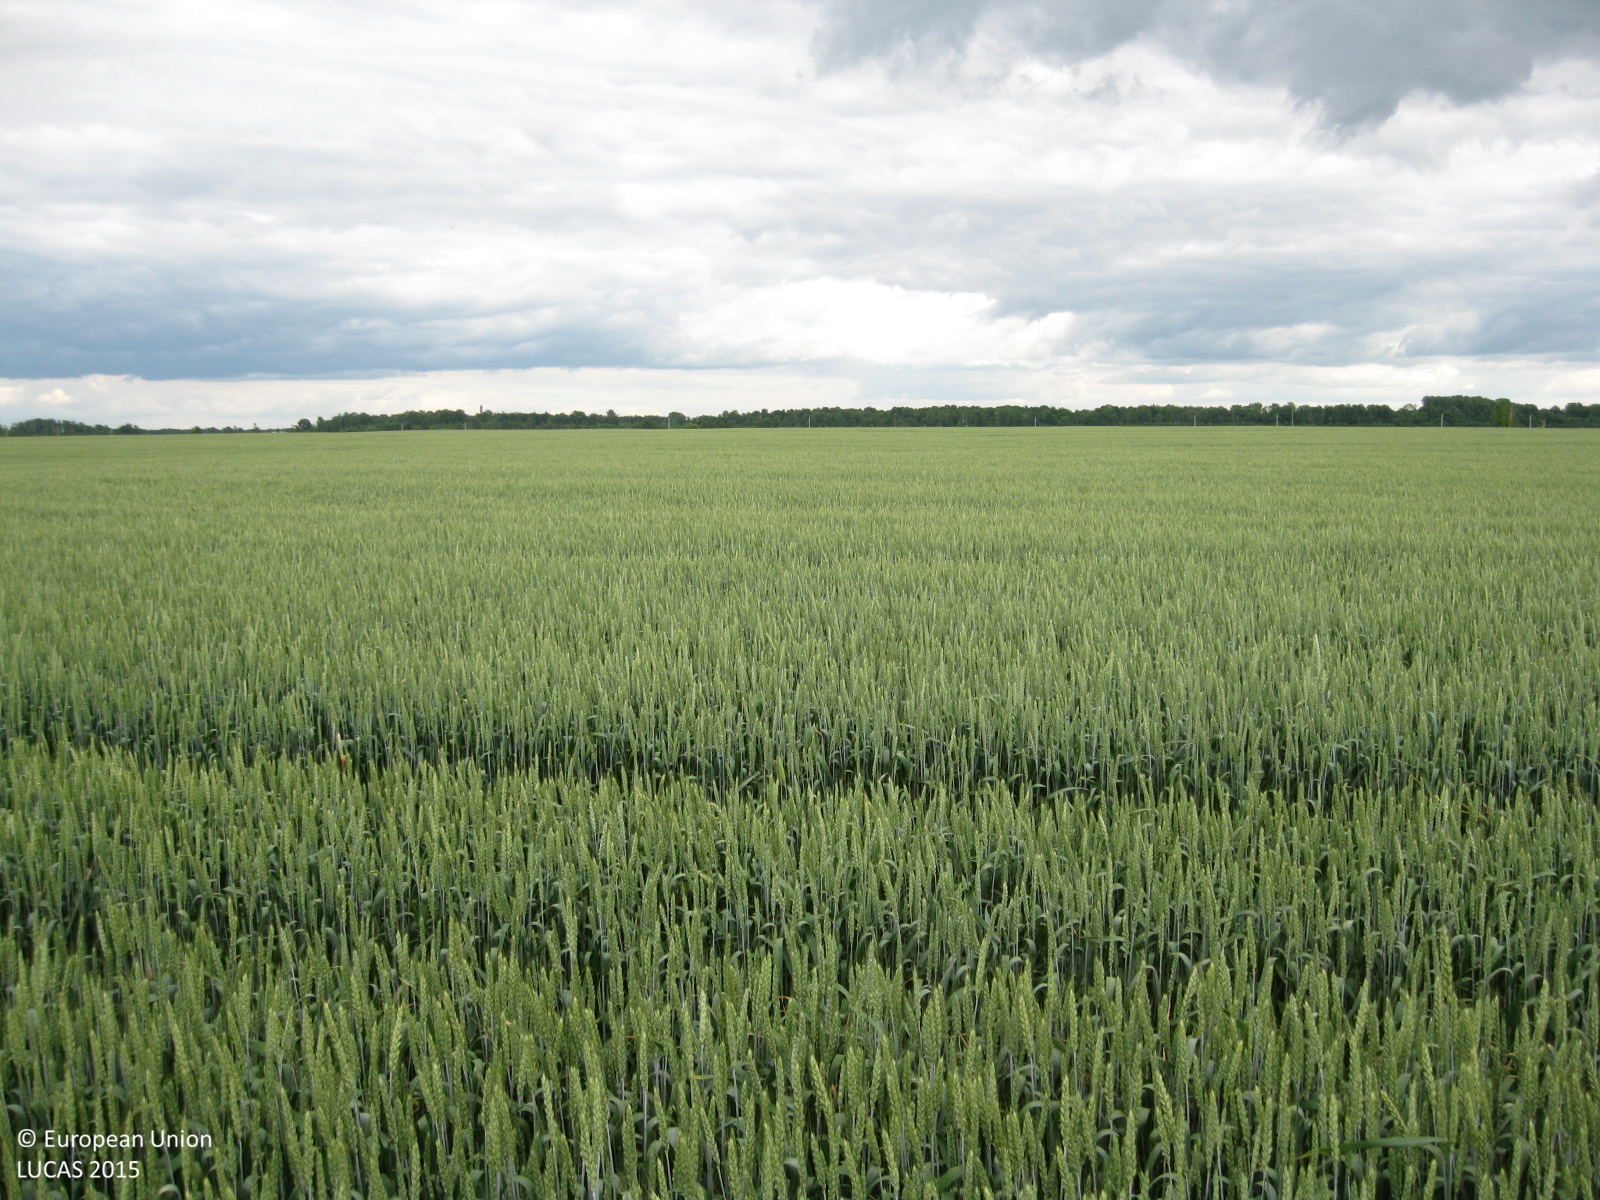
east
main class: Cropland
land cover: Common wheat
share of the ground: > 75 %
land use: Agriculture (excluding fallow land and kitchen gardens)
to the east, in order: Common wheat
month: June
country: LT
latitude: 55.3476
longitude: 24.1114
